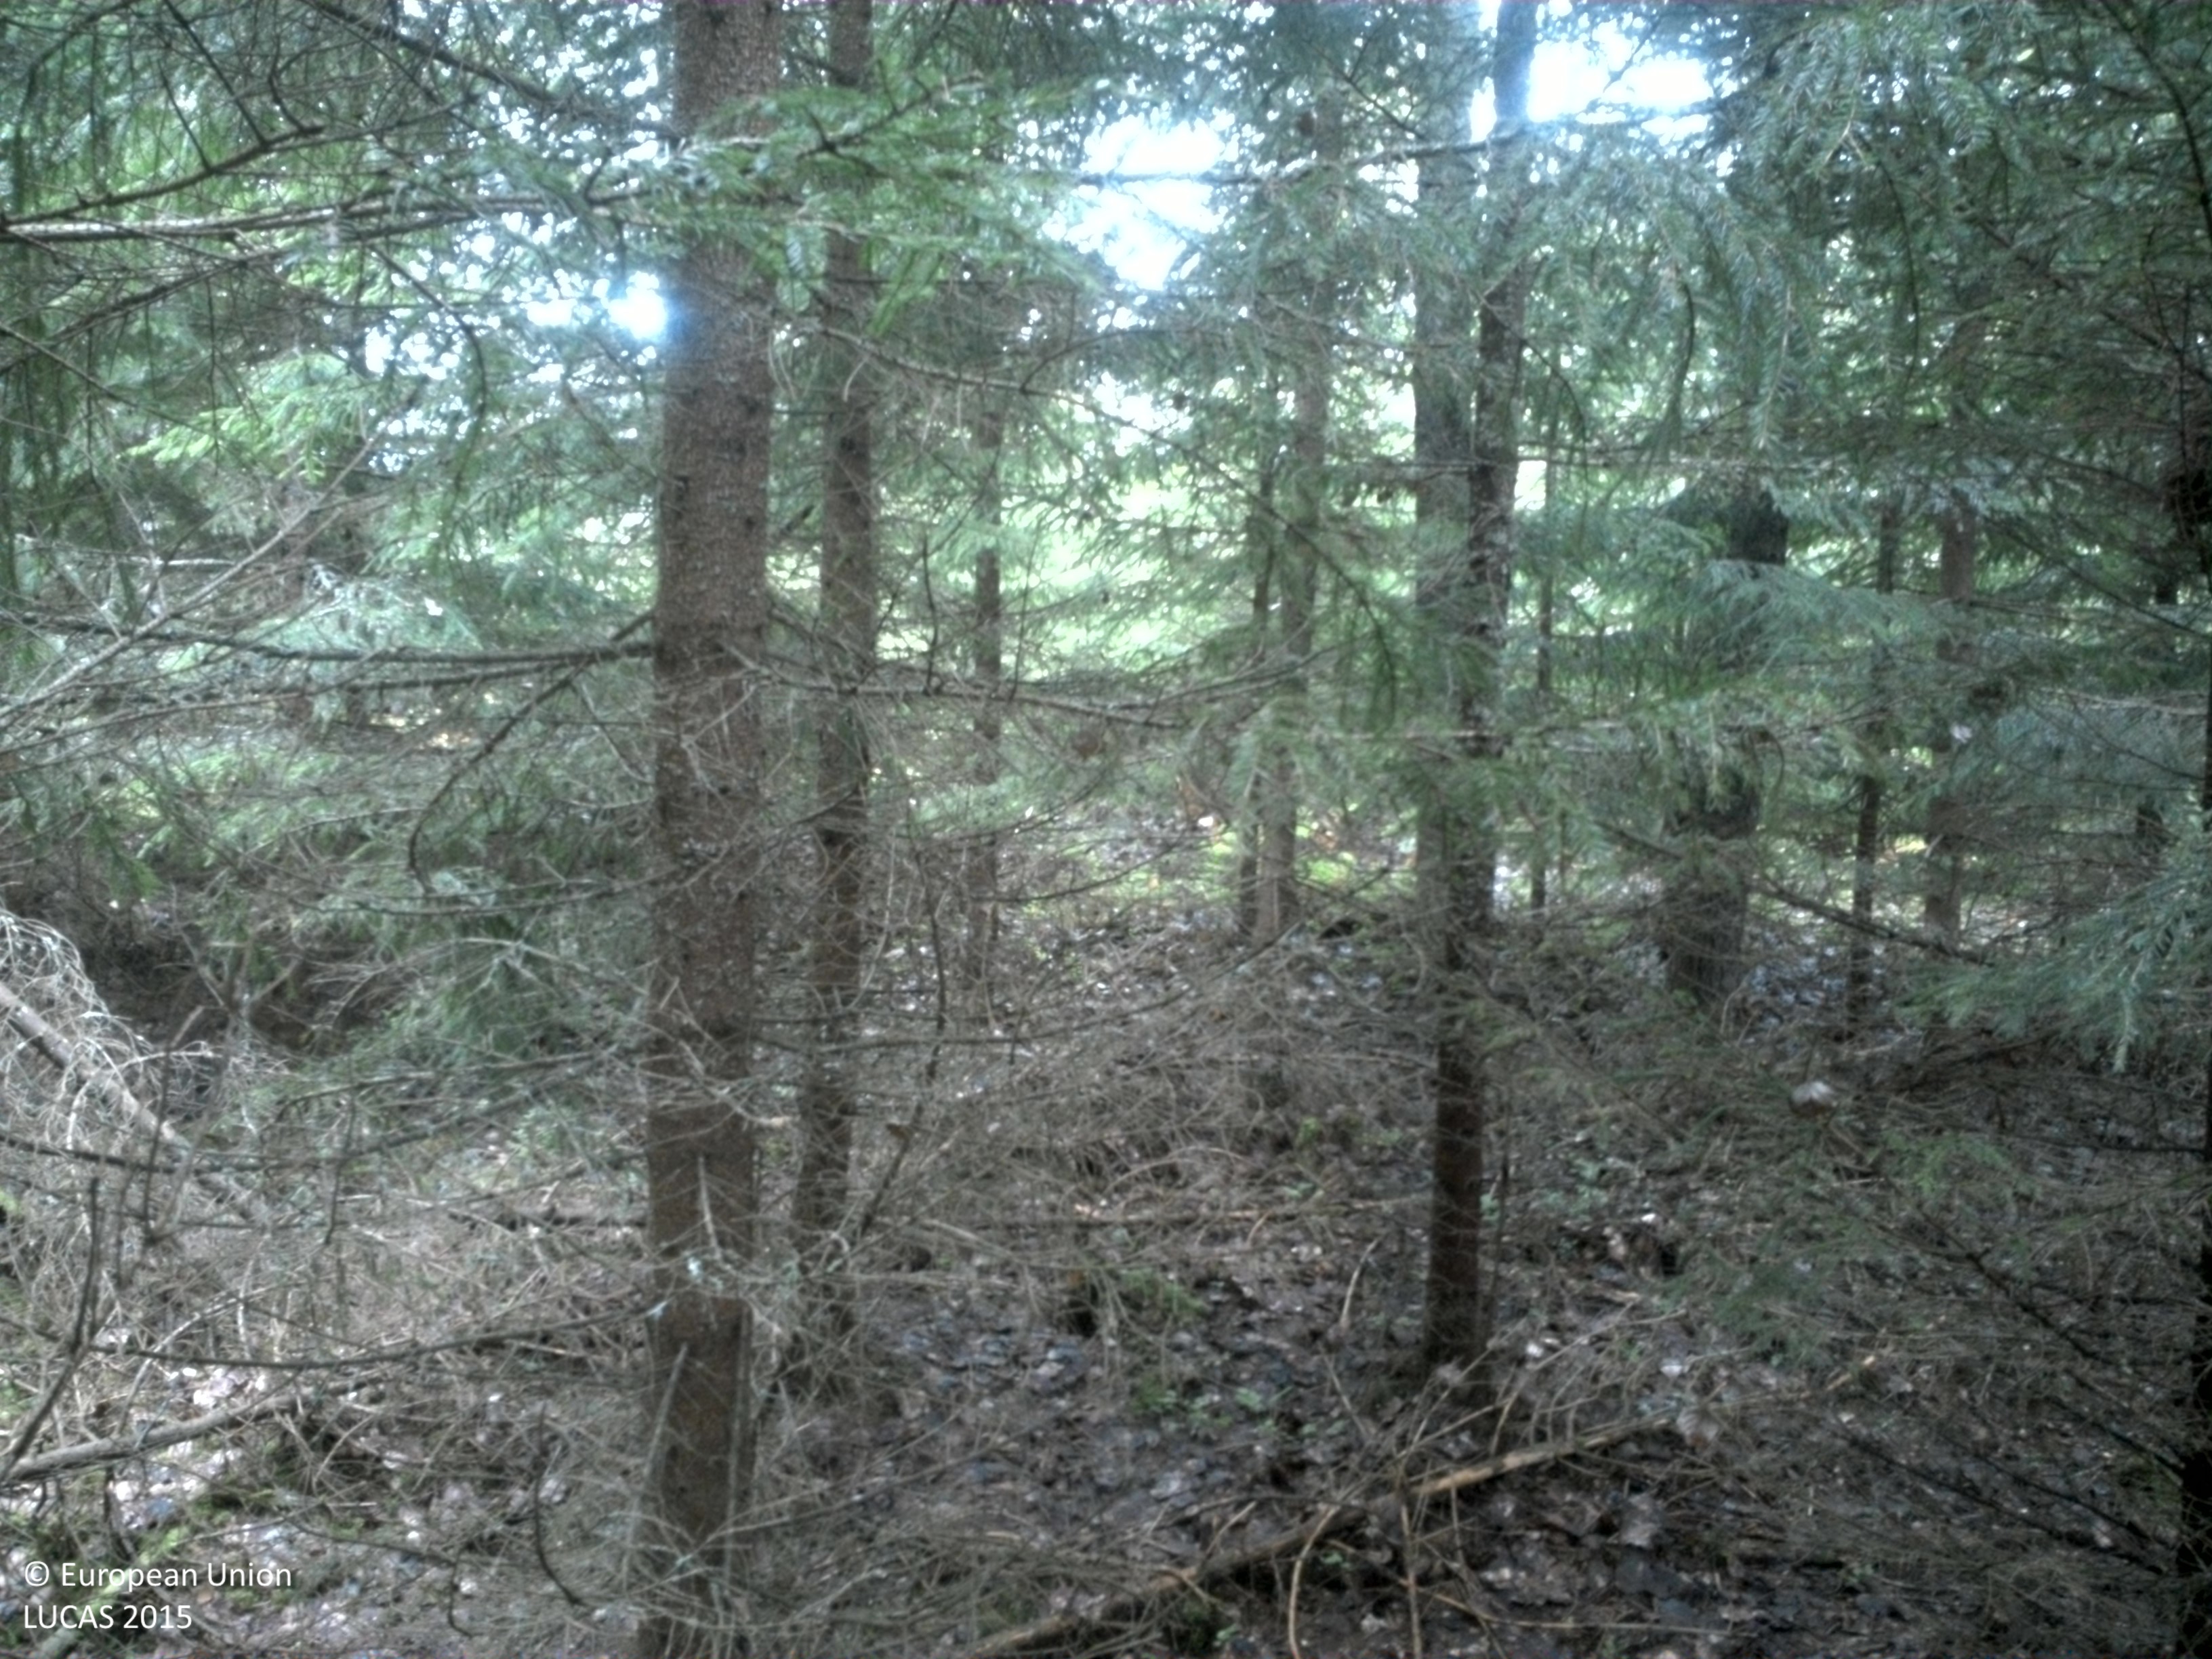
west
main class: Woodland
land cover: Spruce dominated coniferous woodland
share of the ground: > 75 %
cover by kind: coniferous forest trees 80 %, broadleaved forest trees 10 %, lichens and mosses 10 %
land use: Forestry
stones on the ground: < 10 %
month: August
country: SE
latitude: 57.8732
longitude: 13.9568
